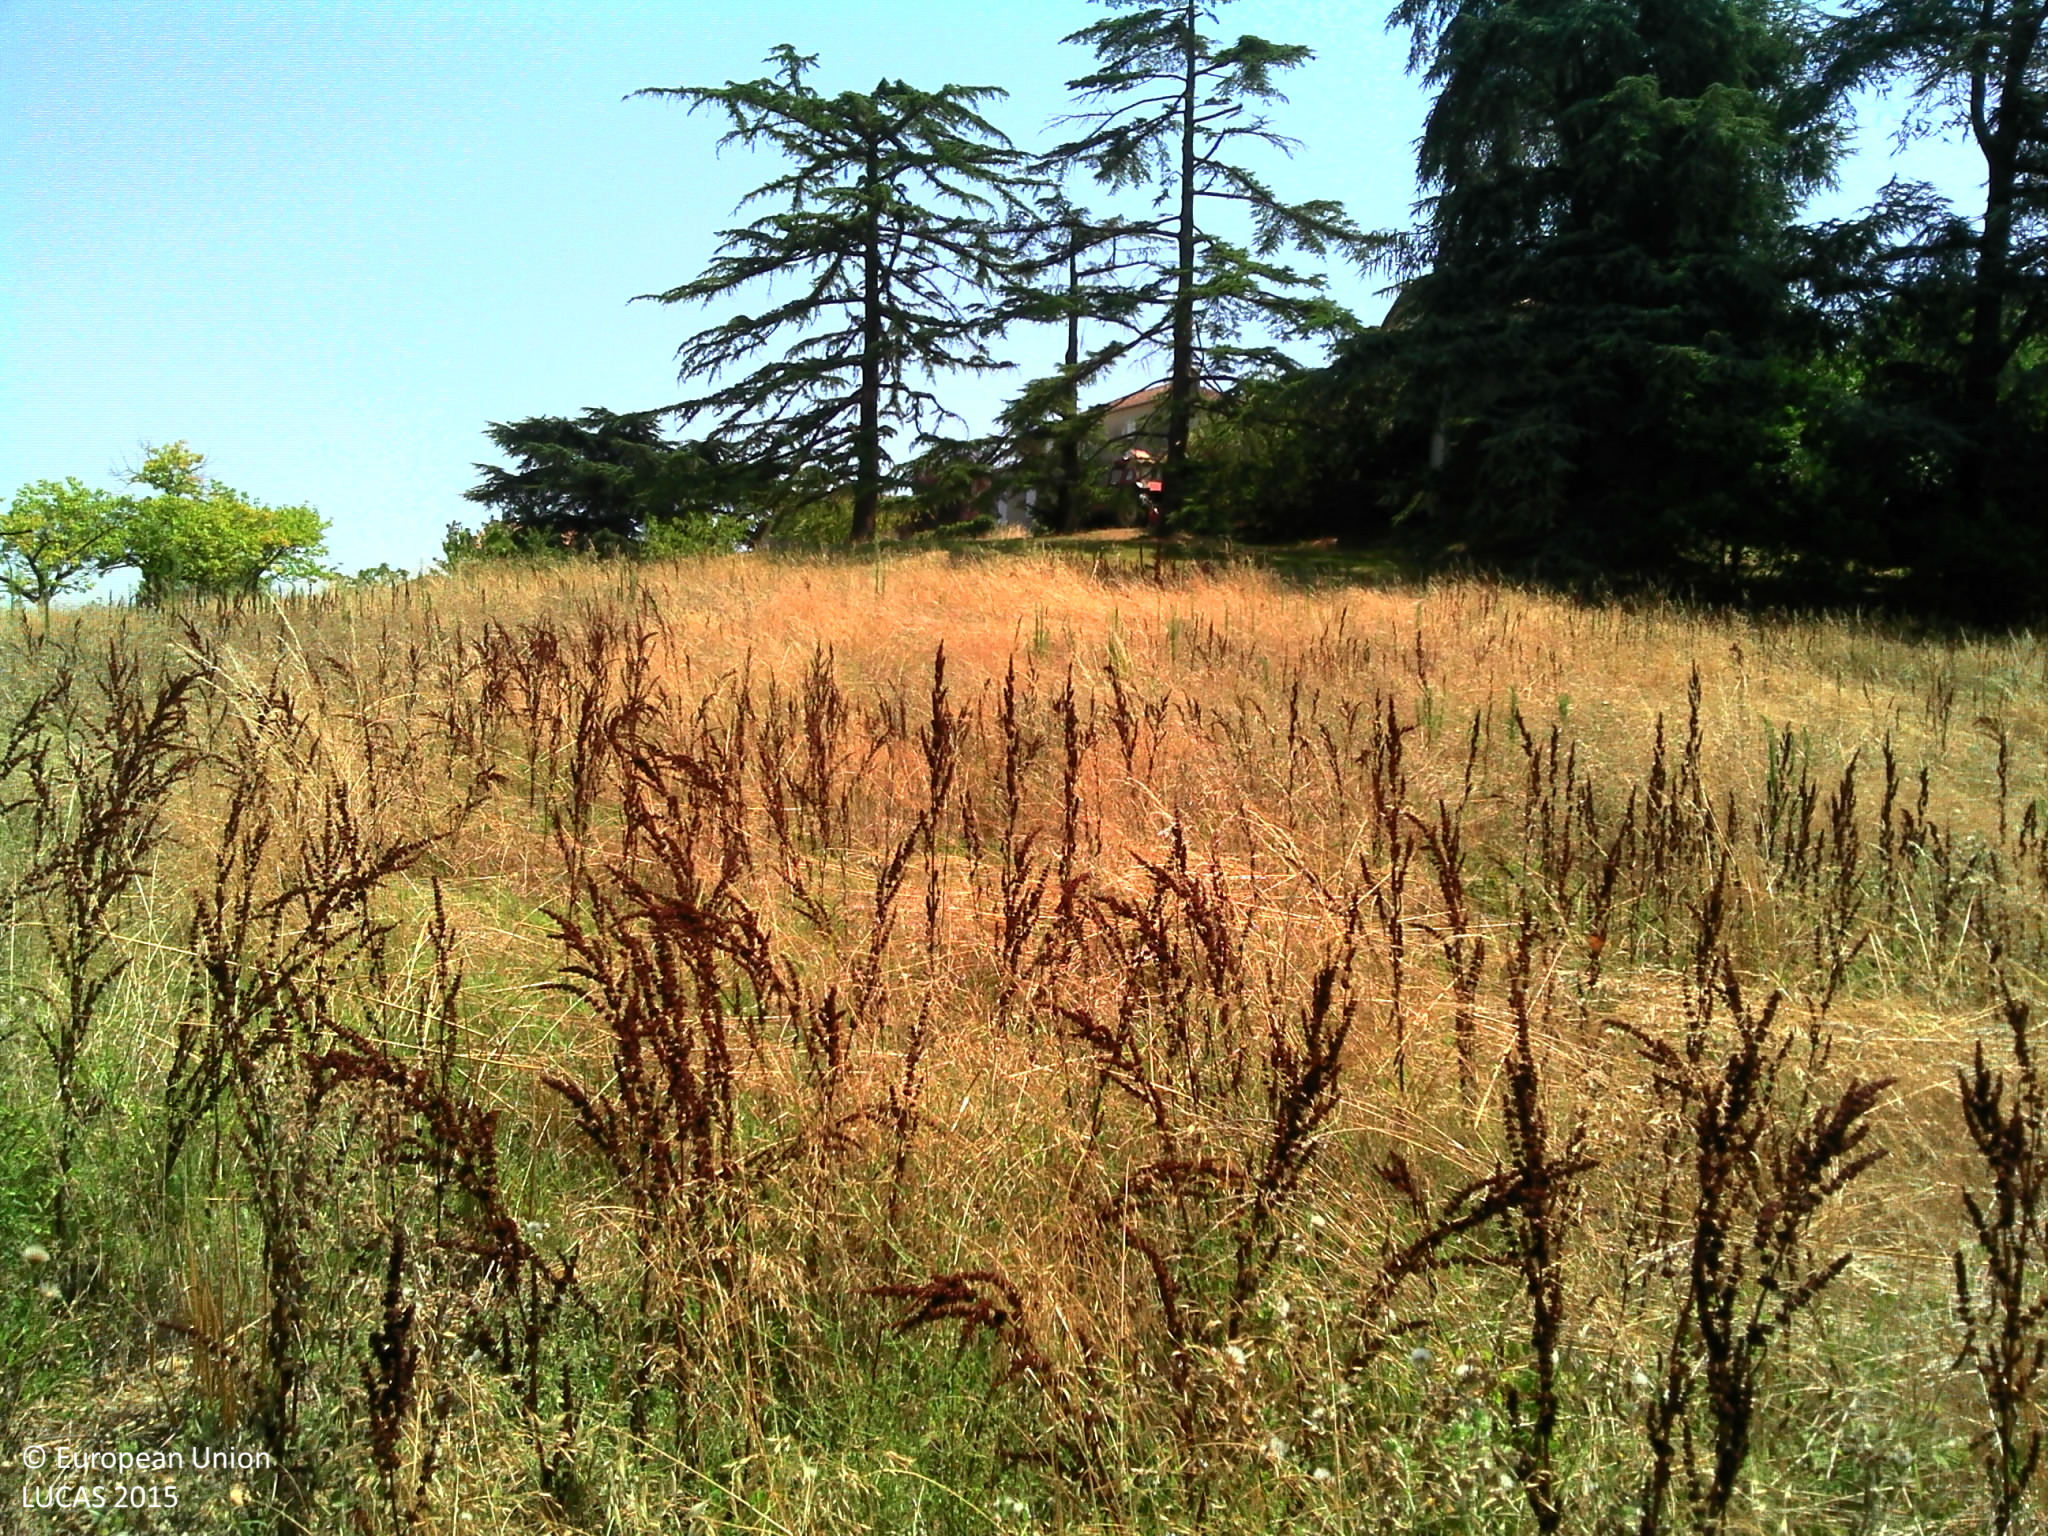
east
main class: Grassland
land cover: Spontaneously vegetated surfaces
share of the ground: > 75 %
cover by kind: herbaceous plants 100 %
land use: Fallow land
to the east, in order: Spontaneously vegetated surfaces; Other coniferous woodland; Artificial constructions in urban areas; Grassland without tree/shrub cover
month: August
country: FR
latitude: 44.1414
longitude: 0.6070
